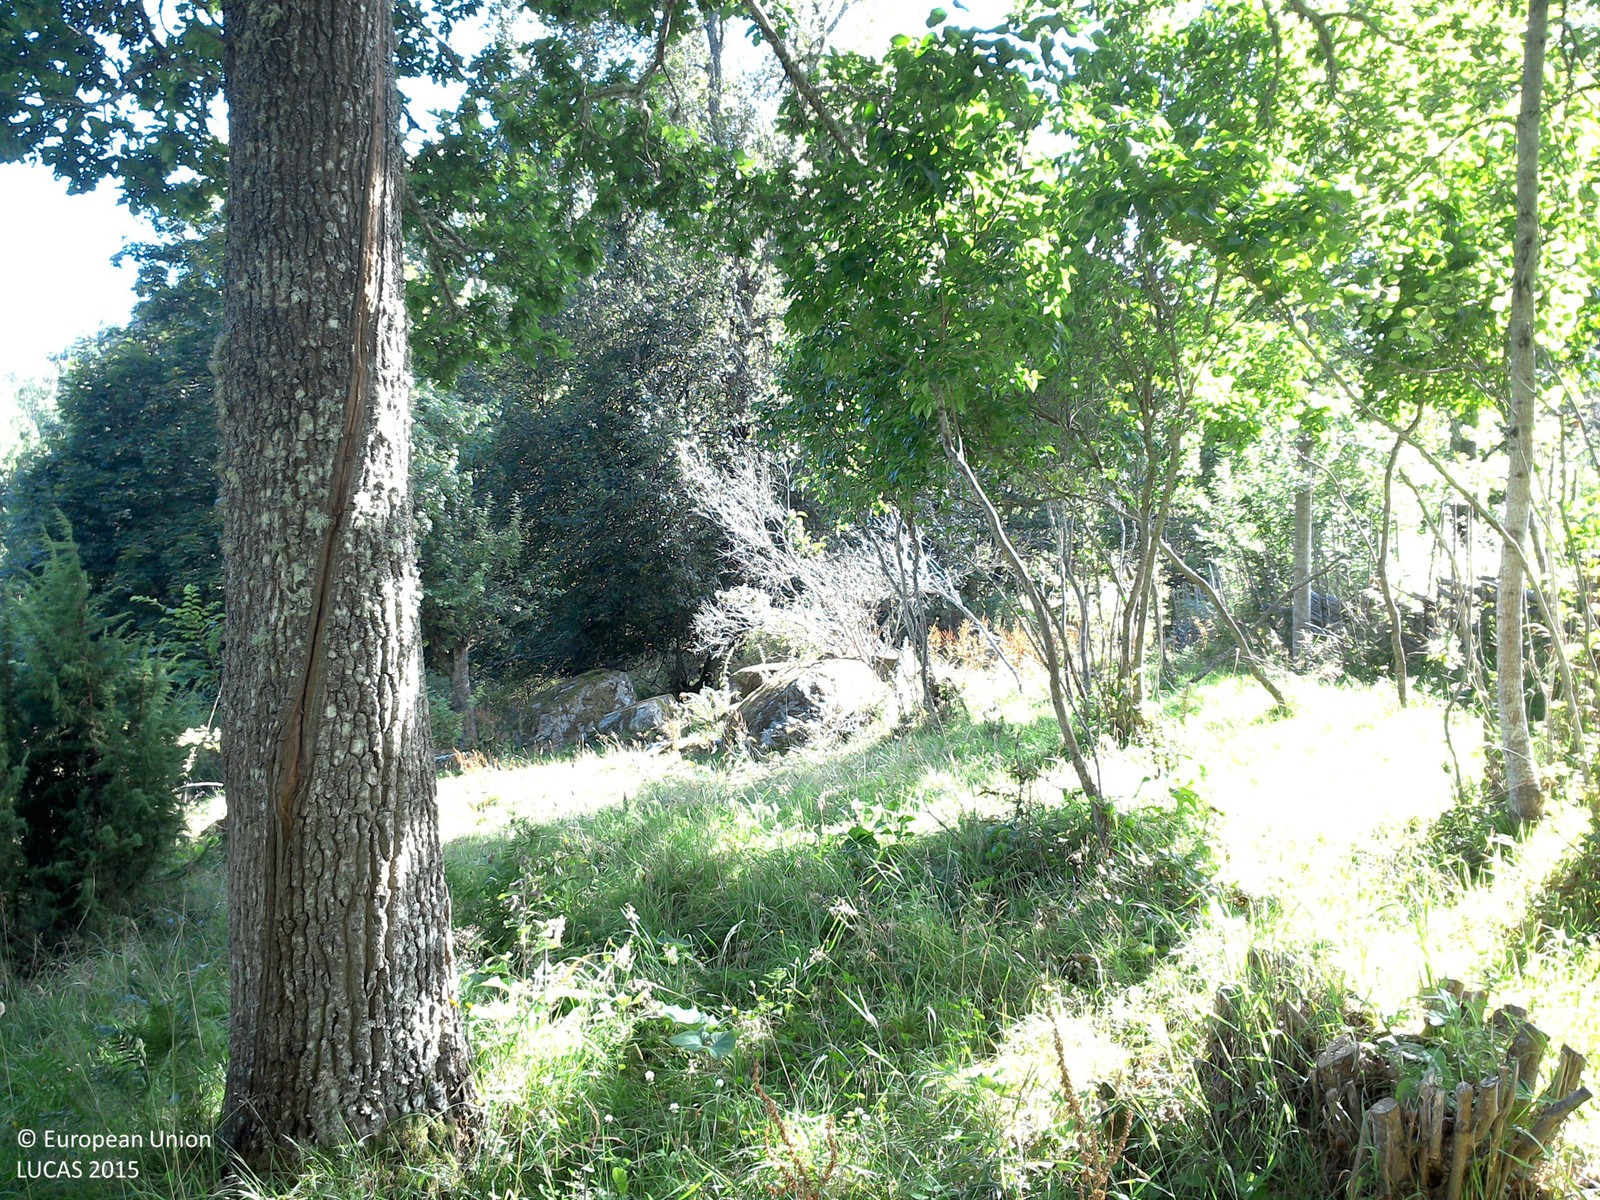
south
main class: Grassland
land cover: Grassland with sparse tree/shrub cover
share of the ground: > 75 %
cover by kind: herbaceous plants 95 %, broadleaved forest trees 5 %
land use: Agriculture (excluding fallow land and kitchen gardens)
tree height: > 5 m
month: August
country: SE
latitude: 57.9866
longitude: 15.3568
